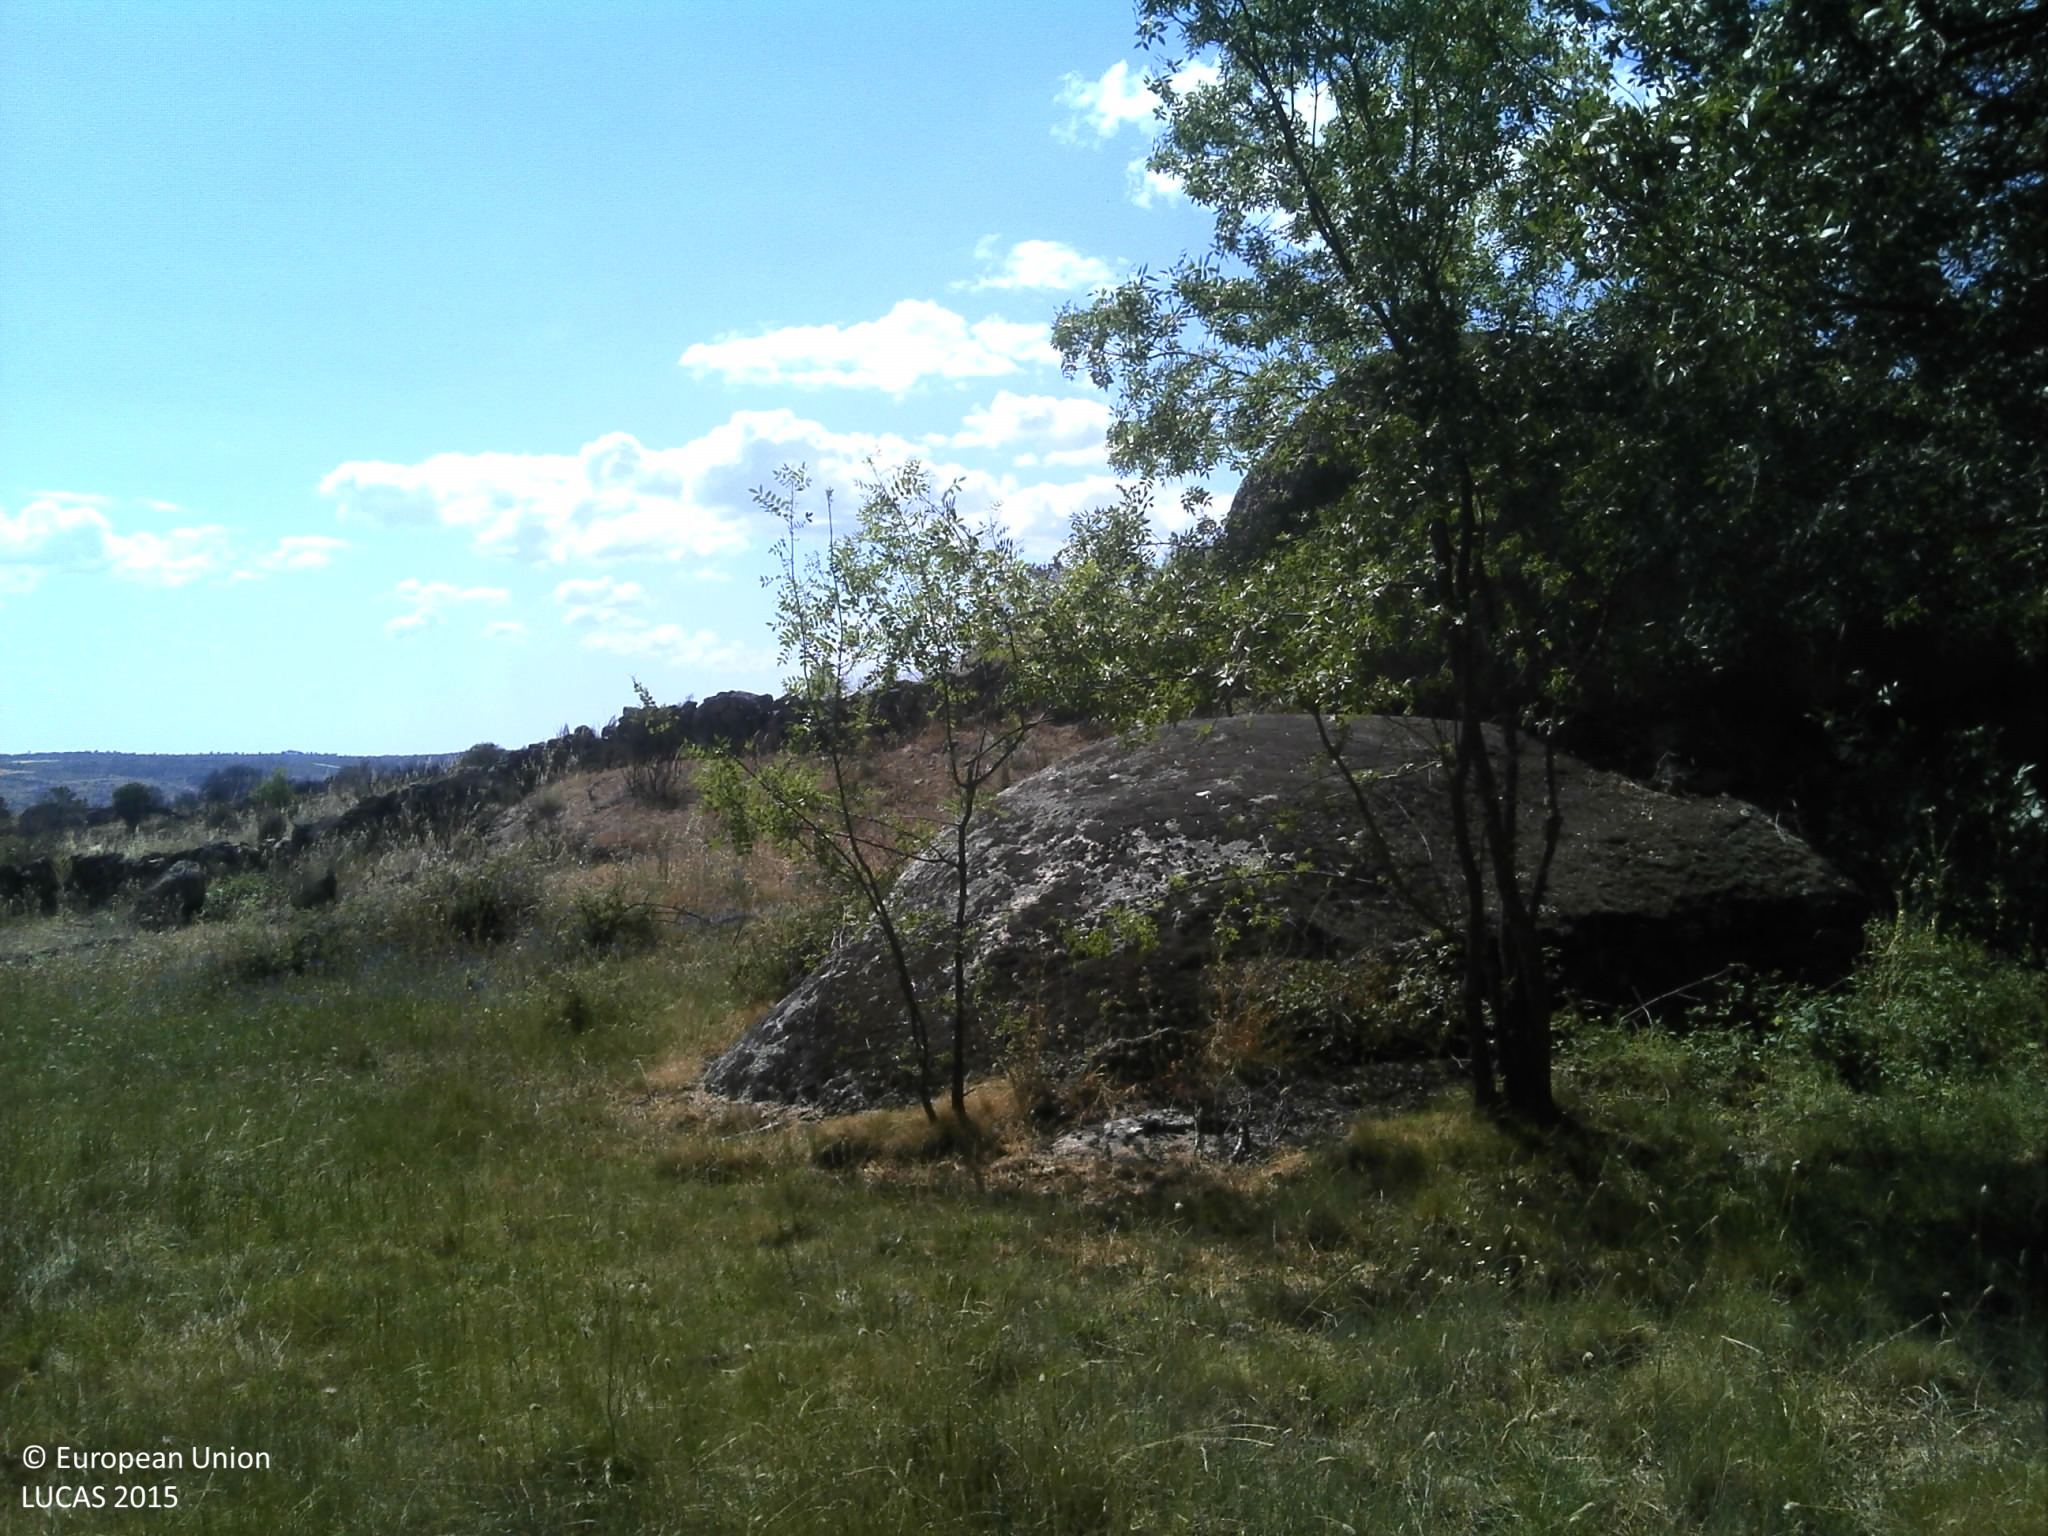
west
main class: Grassland
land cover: Grassland without tree/shrub cover
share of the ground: 50 - 75 %
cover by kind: herbaceous plants 90 %, unconsolidated bare surface 5 %
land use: Agriculture (excluding fallow land and kitchen gardens)
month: June
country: PT
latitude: 40.6893
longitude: -6.8905
